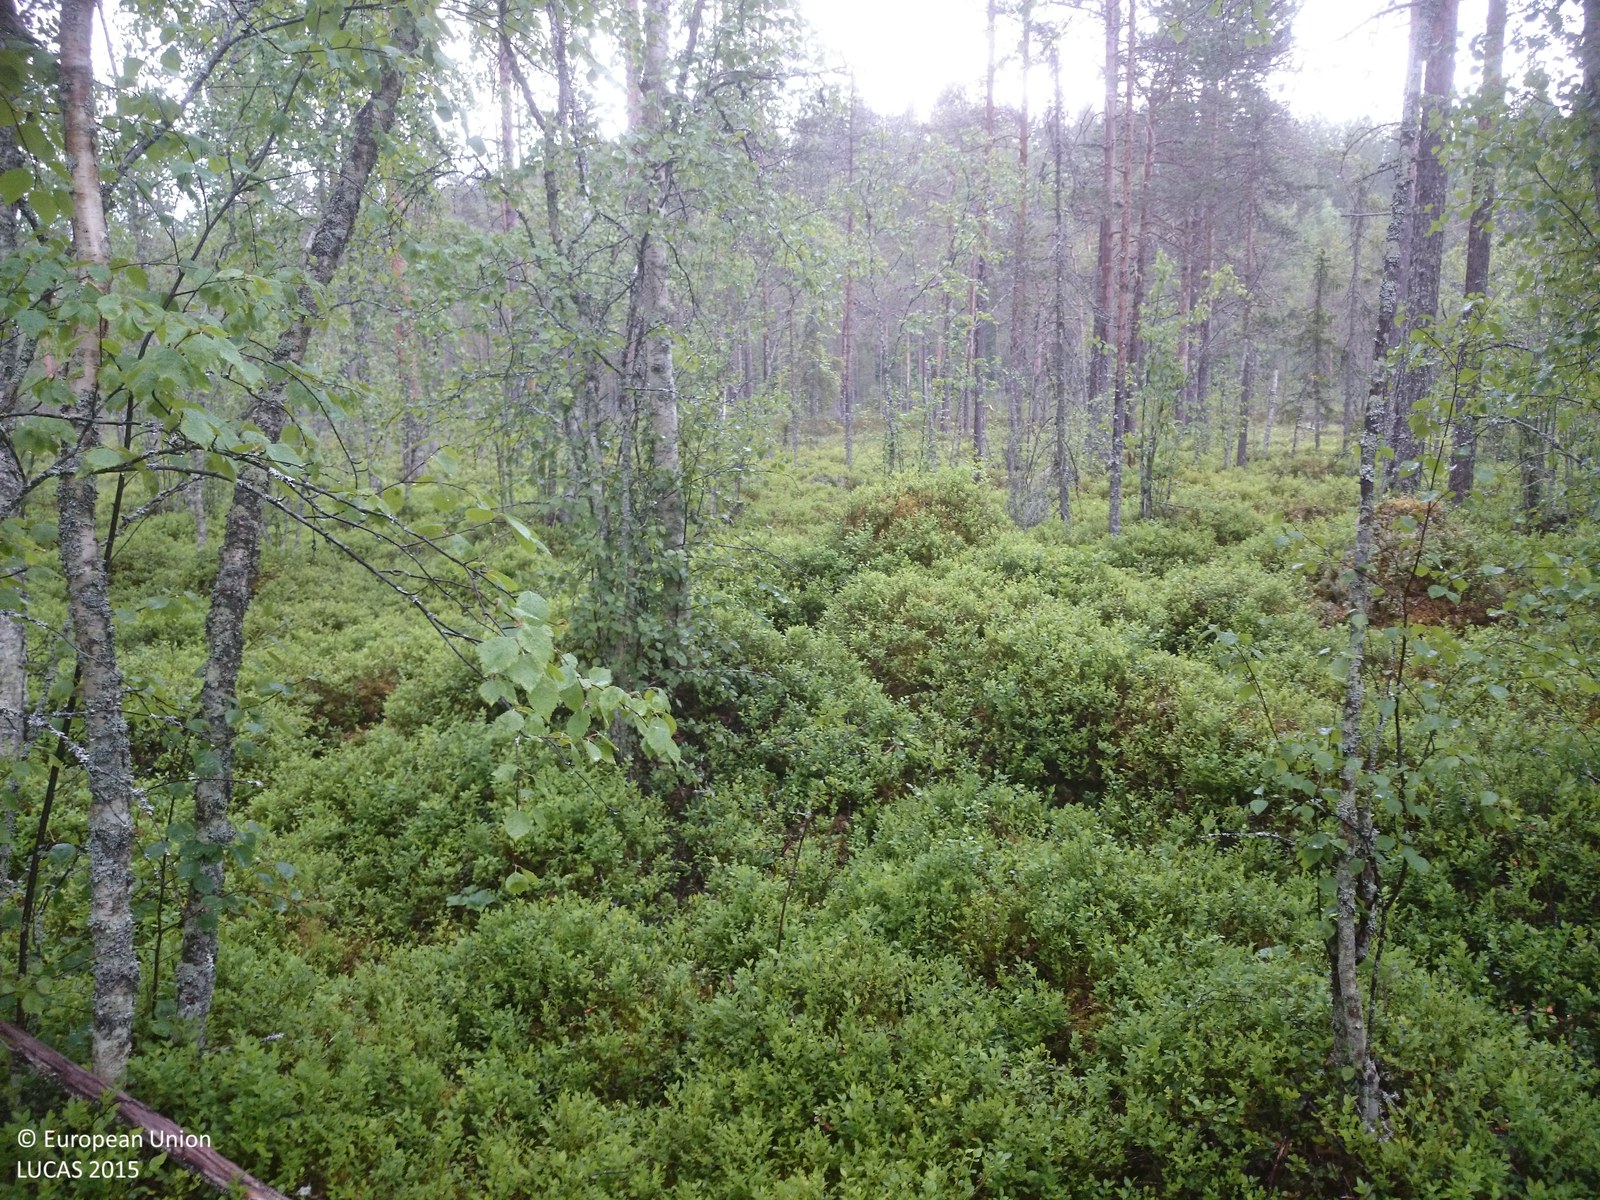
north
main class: Woodland
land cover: Broadleaved woodland
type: hemiboreal forest and nemoral coniferous forest and mixed broadleaved-coniferous forest
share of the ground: 25 - 50 %
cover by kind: shrubs 60 %, broadleaved forest trees 30 %, lichens and mosses 10 %
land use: Semi-natural and natural areas not in use
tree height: > 5 m
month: June
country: SE
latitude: 62.1029
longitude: 16.2459
